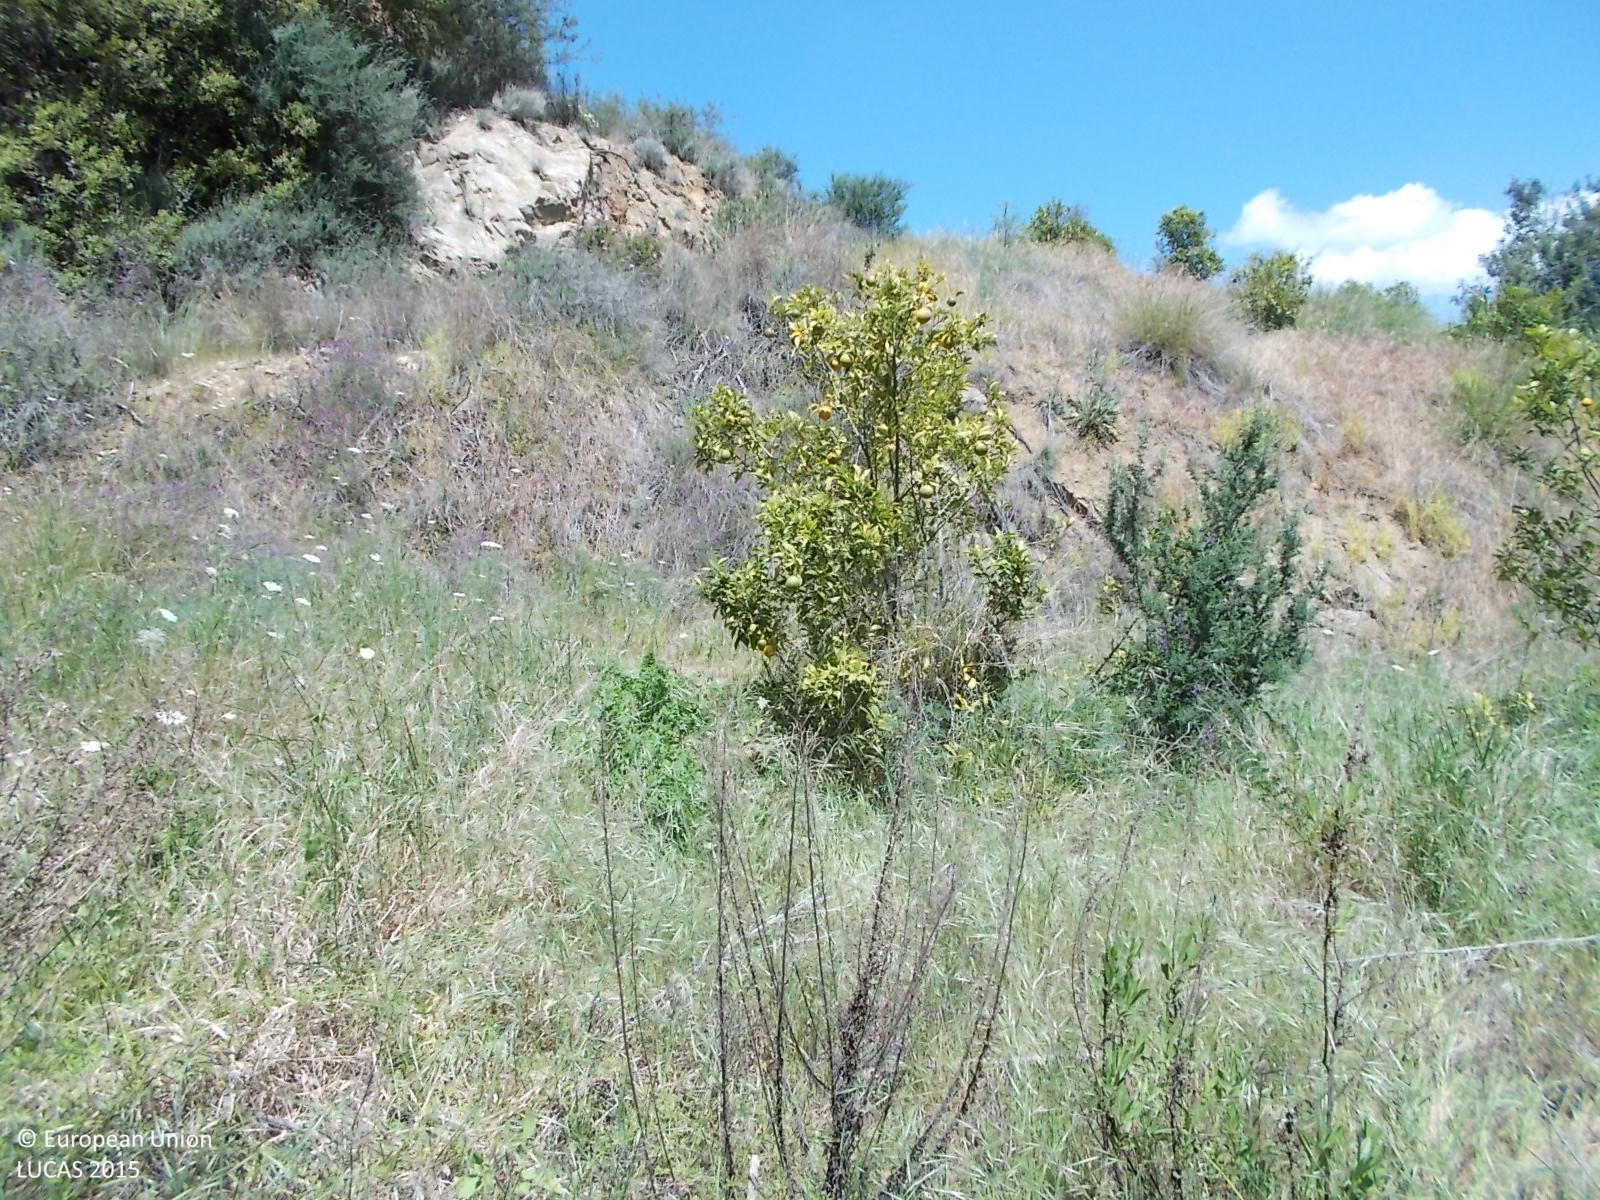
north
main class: Cropland
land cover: Other citrus fruit
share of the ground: 10 - 25 %
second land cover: Spontaneously vegetated surfaces
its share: > 75 %
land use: Abandoned areas
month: April
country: CY
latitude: 34.8248
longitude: 33.0994
